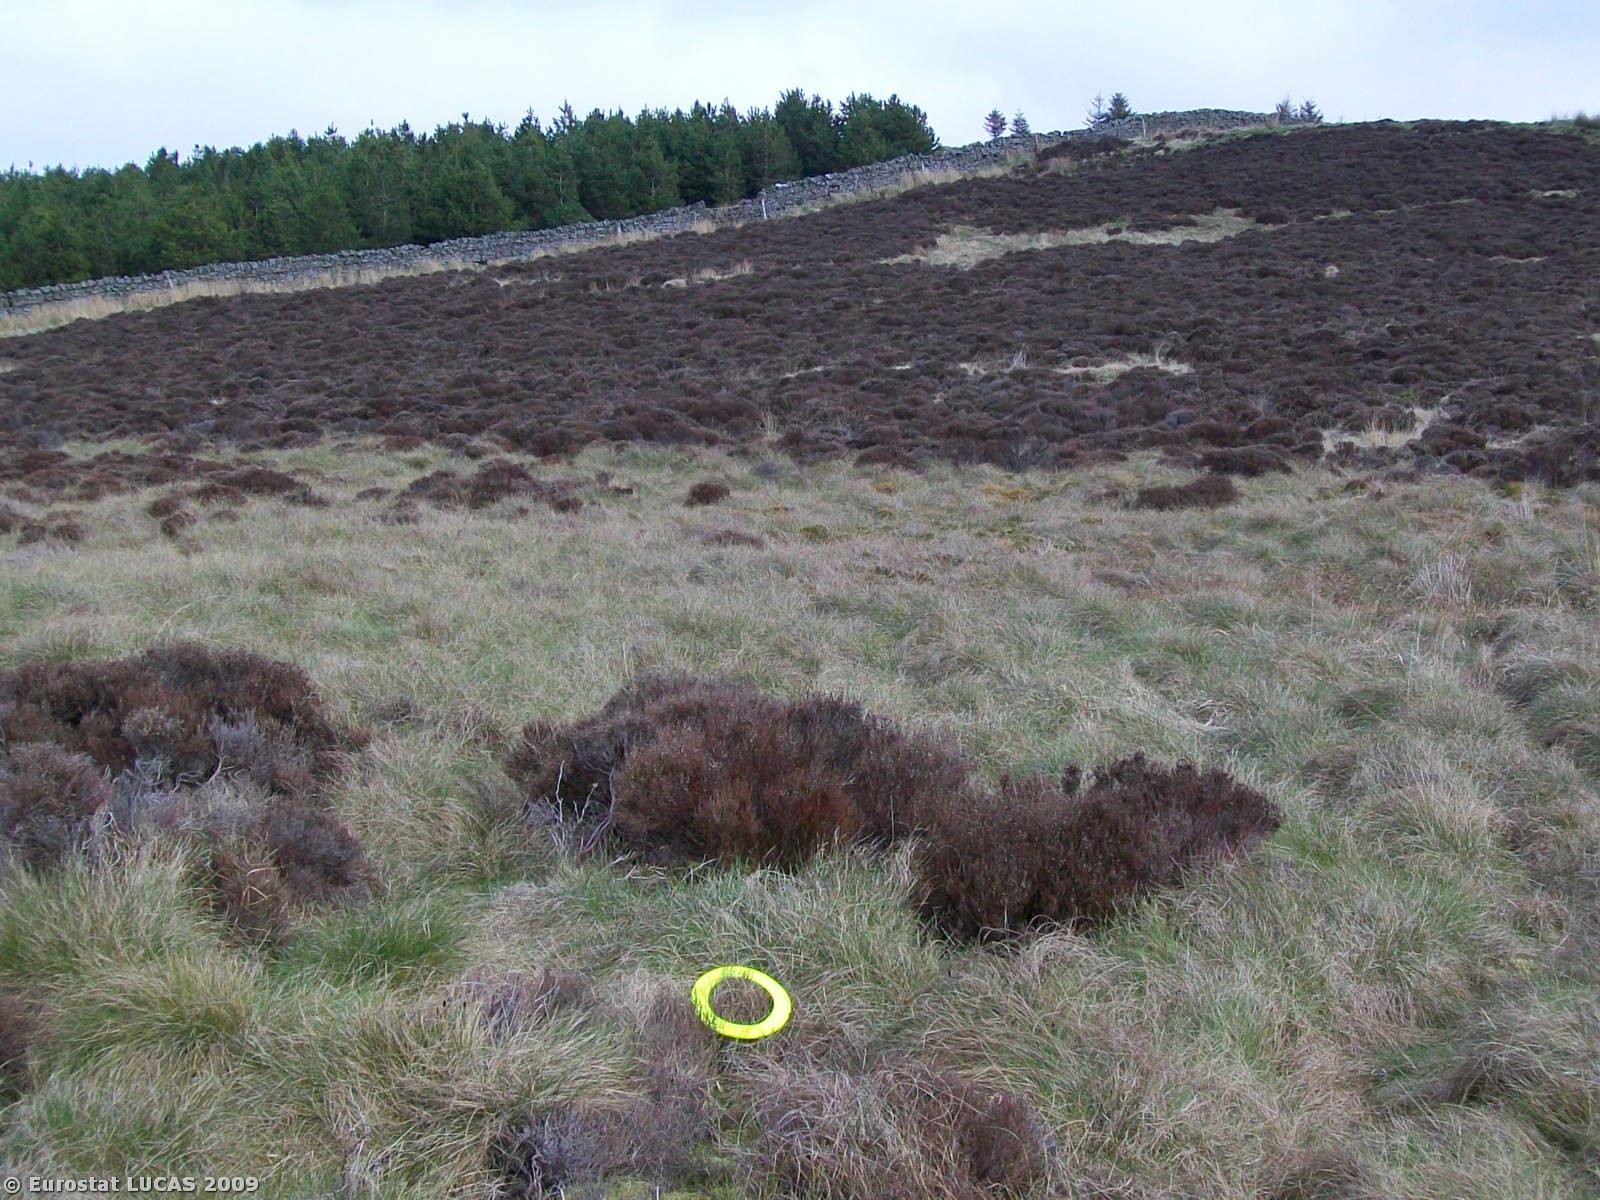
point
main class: Shrubland
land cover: Shrubland without tree cover
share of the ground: > 75 %
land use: Agriculture (excluding fallow land and kitchen gardens)
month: April
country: GB
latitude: 55.1552
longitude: -2.1245
